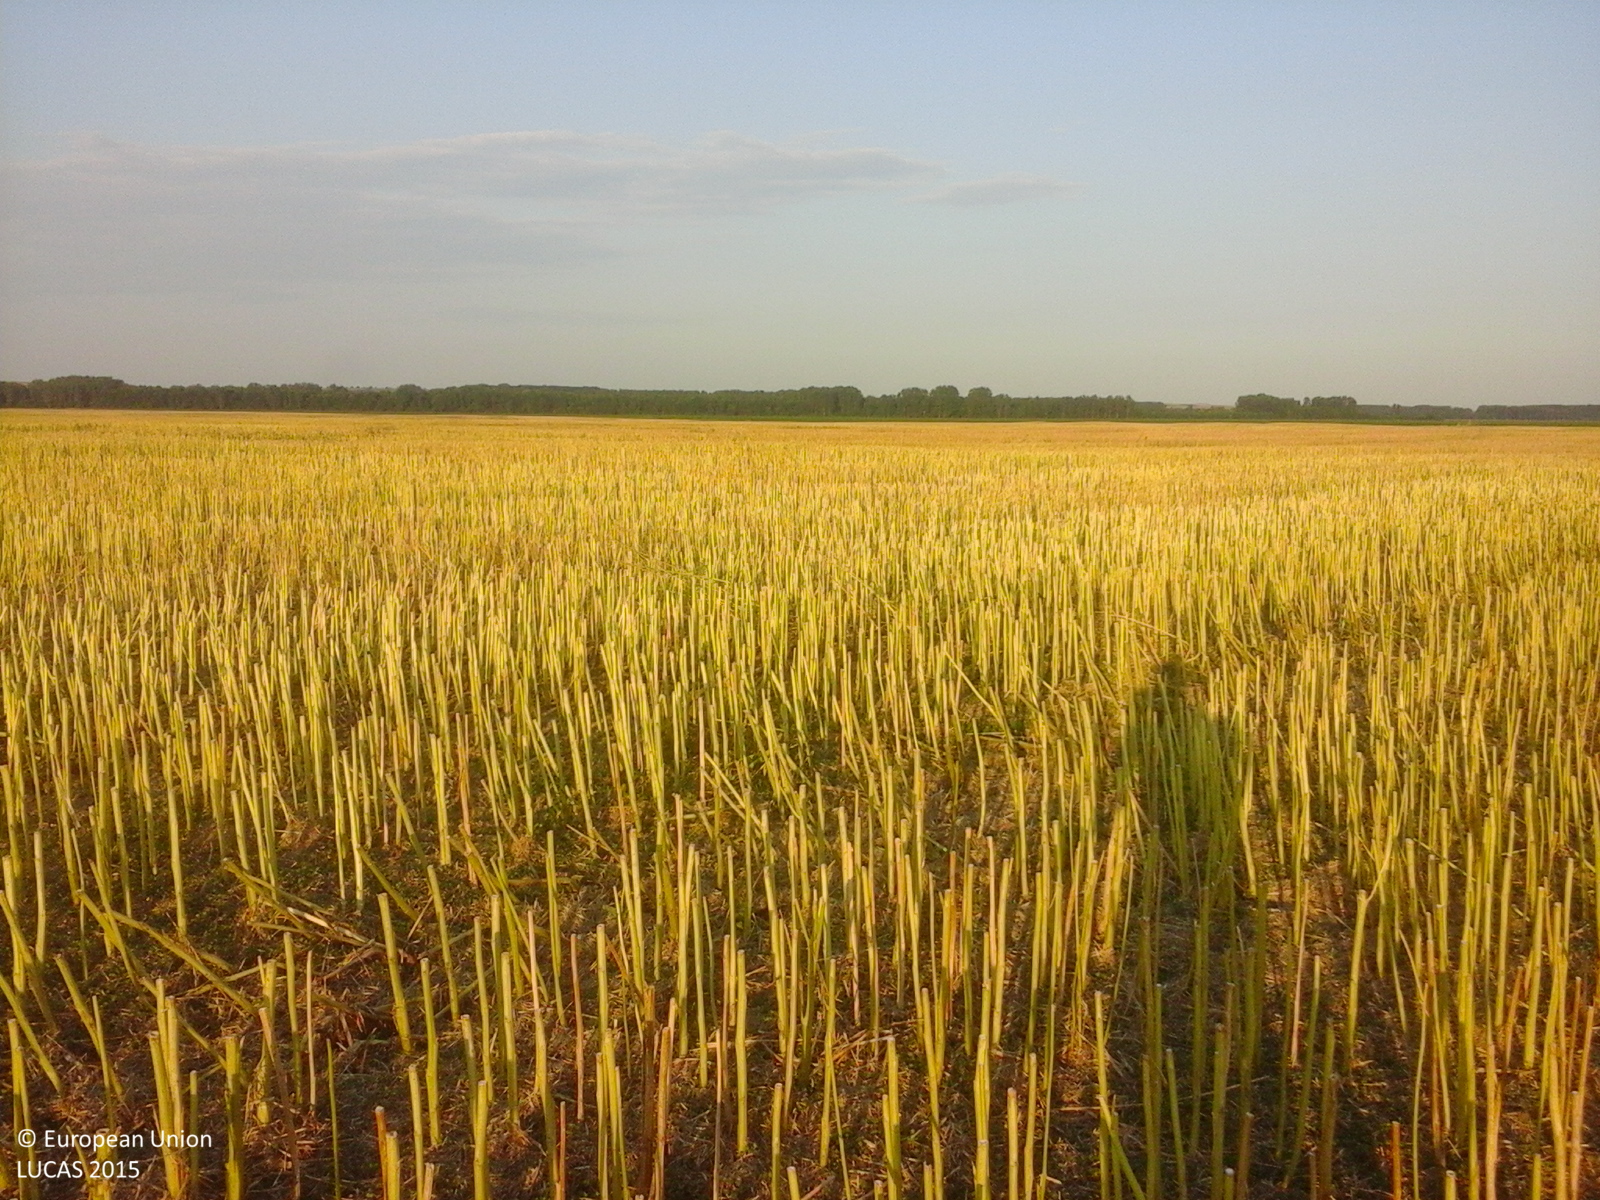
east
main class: Cropland
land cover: Rape and turnip rape
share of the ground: < 10 %
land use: Agriculture (excluding fallow land and kitchen gardens)
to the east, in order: Rape and turnip rape
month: July
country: RO
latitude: 44.3559
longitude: 24.3315
